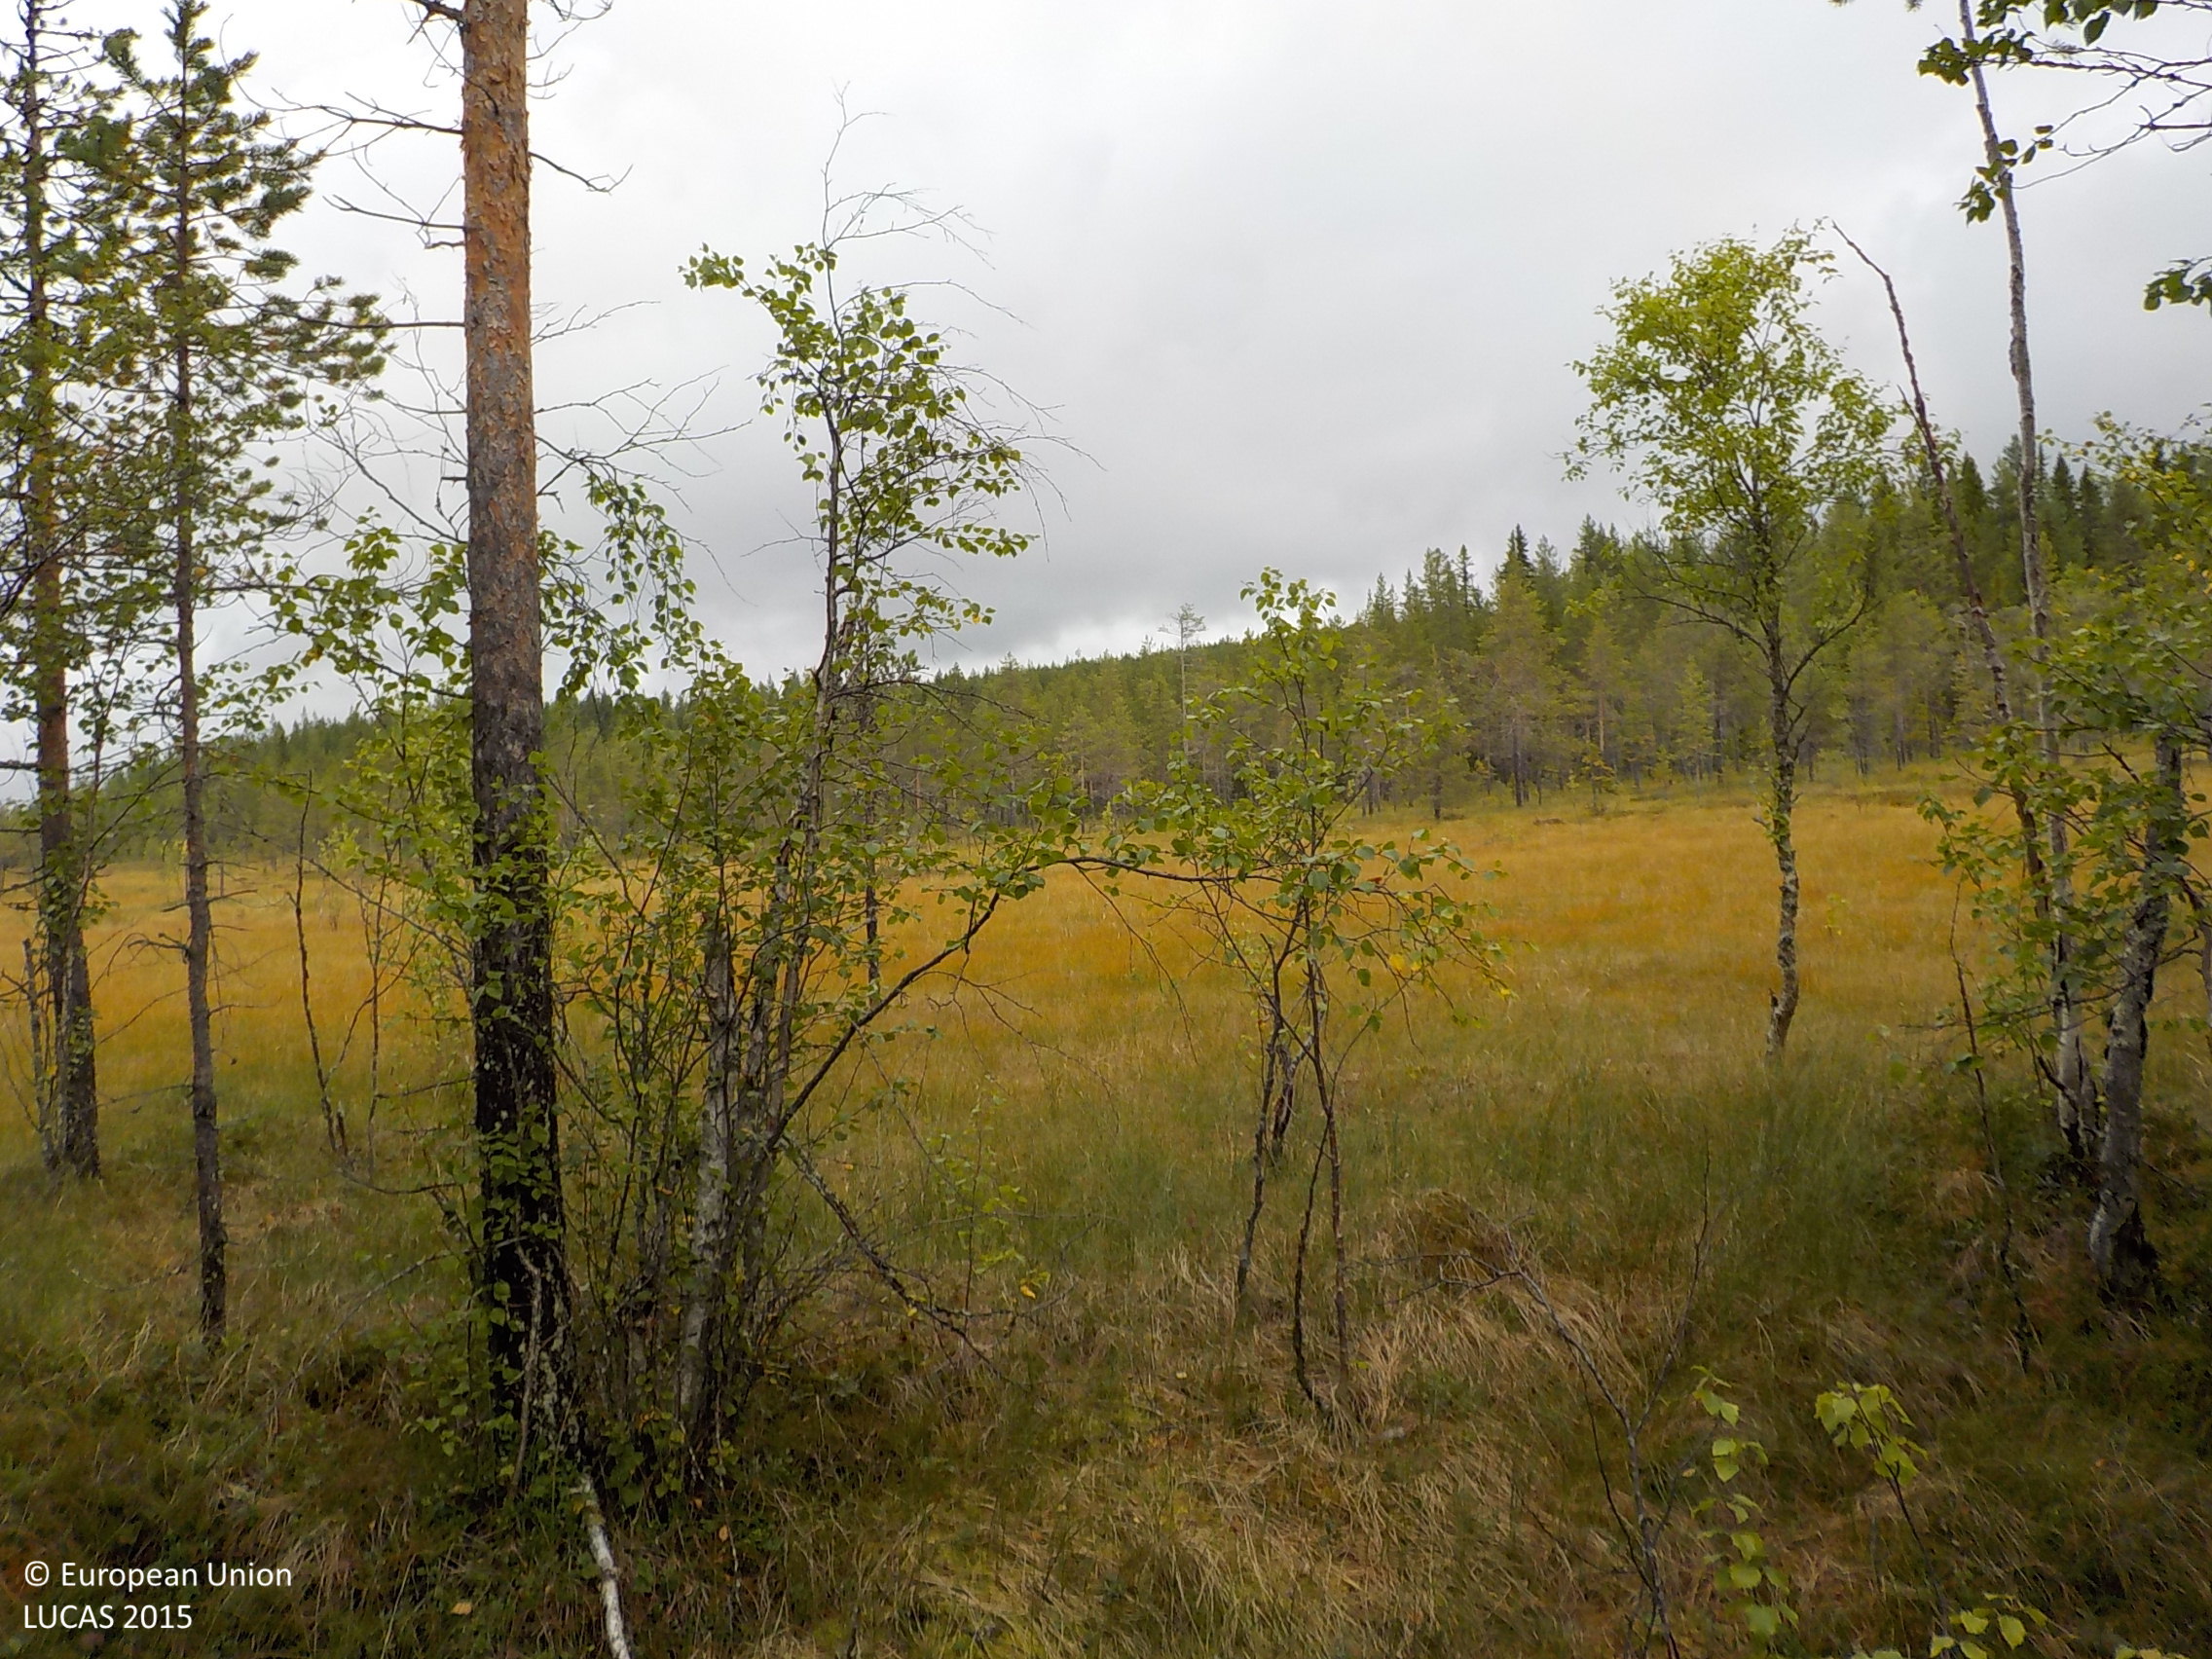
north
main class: Woodland
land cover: Pine dominated mixed woodland
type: boreal forest
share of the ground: 50 - 75 %
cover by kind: coniferous forest trees 40 %, broadleaved forest trees 30 %, lichens and mosses 15 %, shrubs 10 %, herbaceous plants 5 %
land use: Forestry
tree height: > 5 m
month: August
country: SE
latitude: 64.0174
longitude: 17.1923
